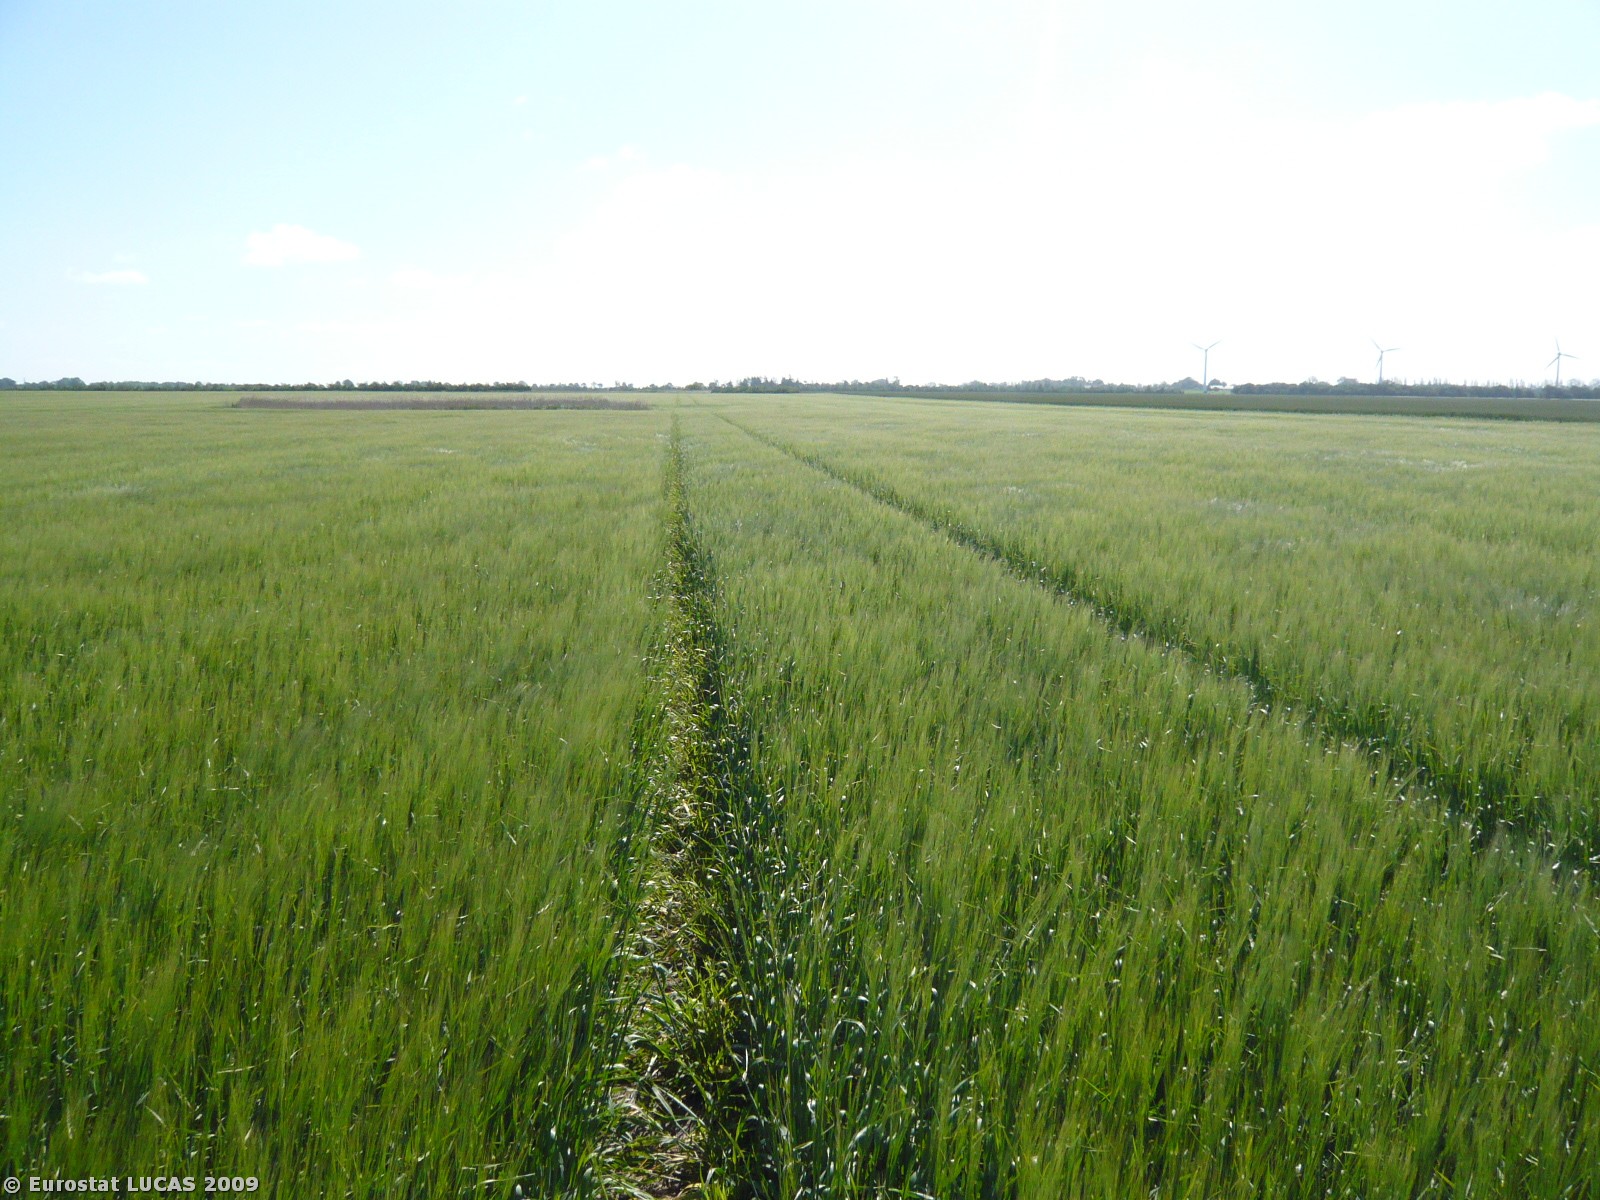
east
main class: Cropland
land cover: Barley
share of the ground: > 75 %
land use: Agriculture (excluding fallow land and kitchen gardens)
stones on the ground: < 10 %
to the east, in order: Barley
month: June
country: DK
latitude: 54.7991
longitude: 11.0725
